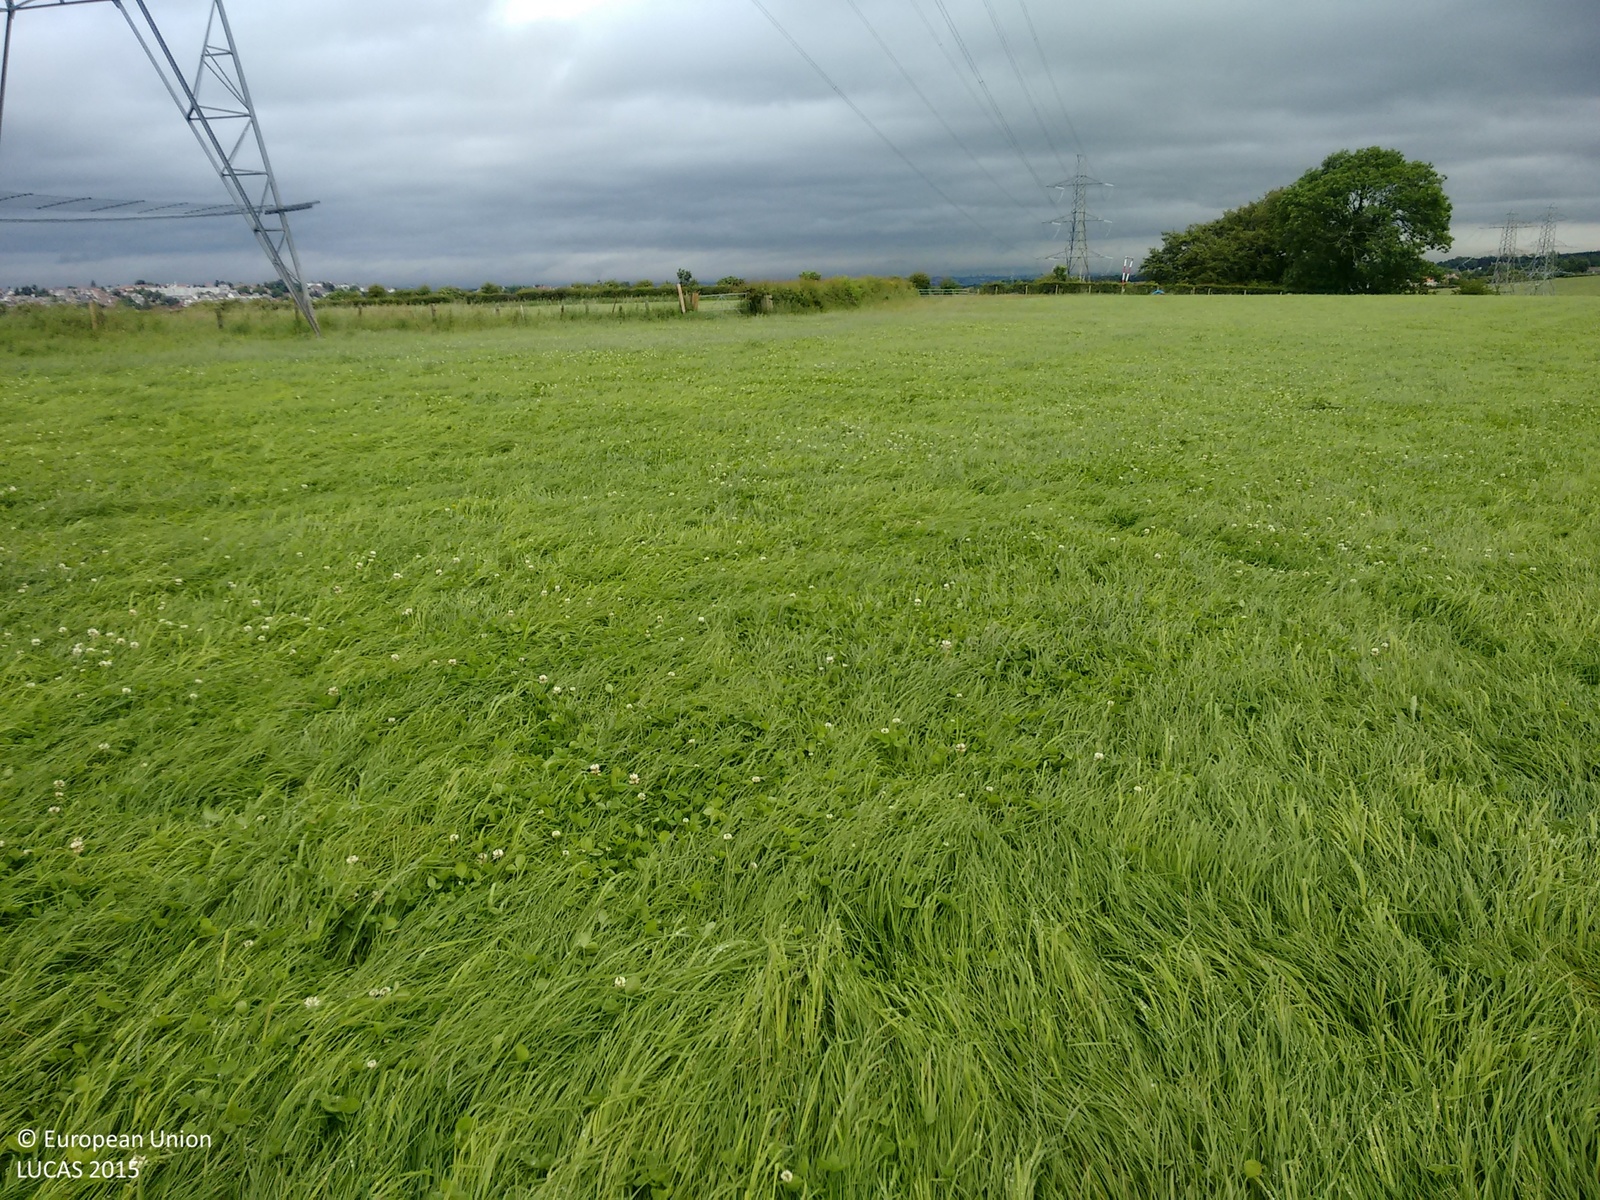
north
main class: Grassland
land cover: Grassland without tree/shrub cover
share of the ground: > 75 %
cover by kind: herbaceous plants 100 %
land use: Agriculture (excluding fallow land and kitchen gardens)
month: July
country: GB
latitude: 55.7692
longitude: -4.2643
